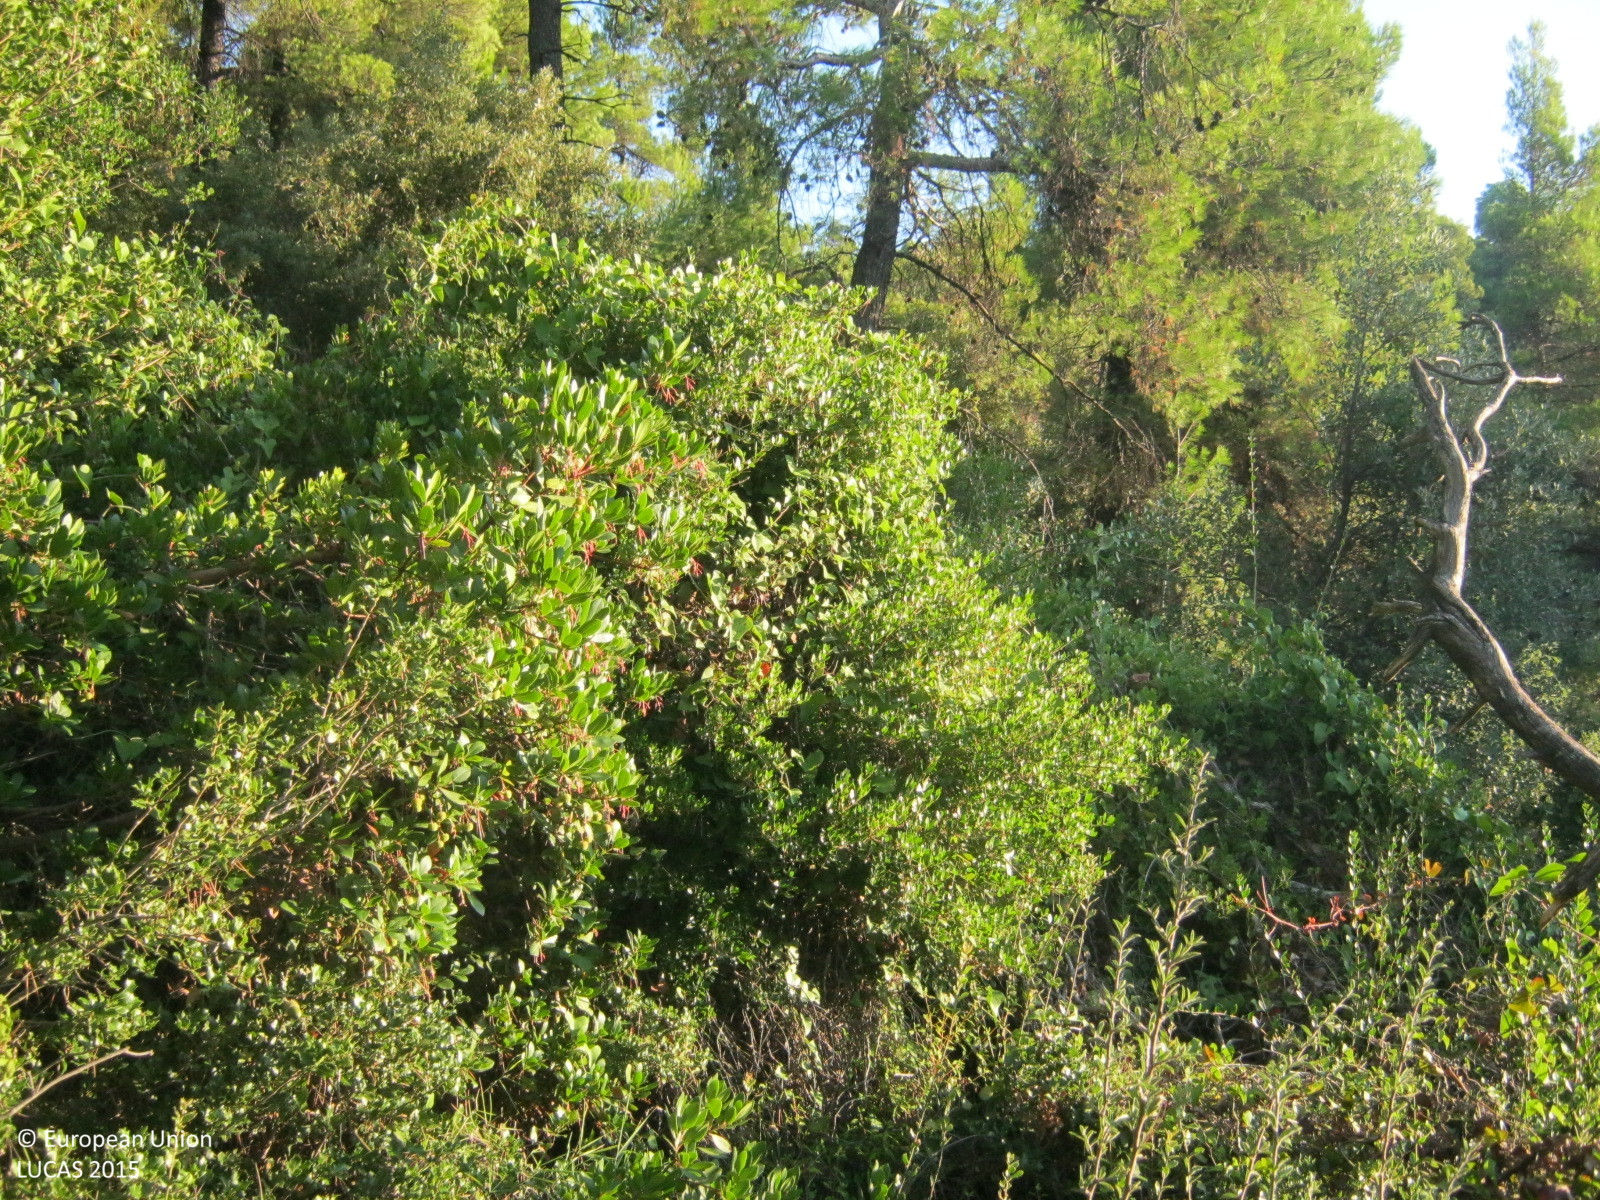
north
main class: Woodland
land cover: Pine dominated mixed woodland
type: coniferous forest of the mediterranean region
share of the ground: > 75 %
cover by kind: coniferous forest trees 65 %, broadleaved forest trees 25 %, shrubs 10 %
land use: Forestry
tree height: > 5 m
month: August
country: GR
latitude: 38.6402
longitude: 23.5795
